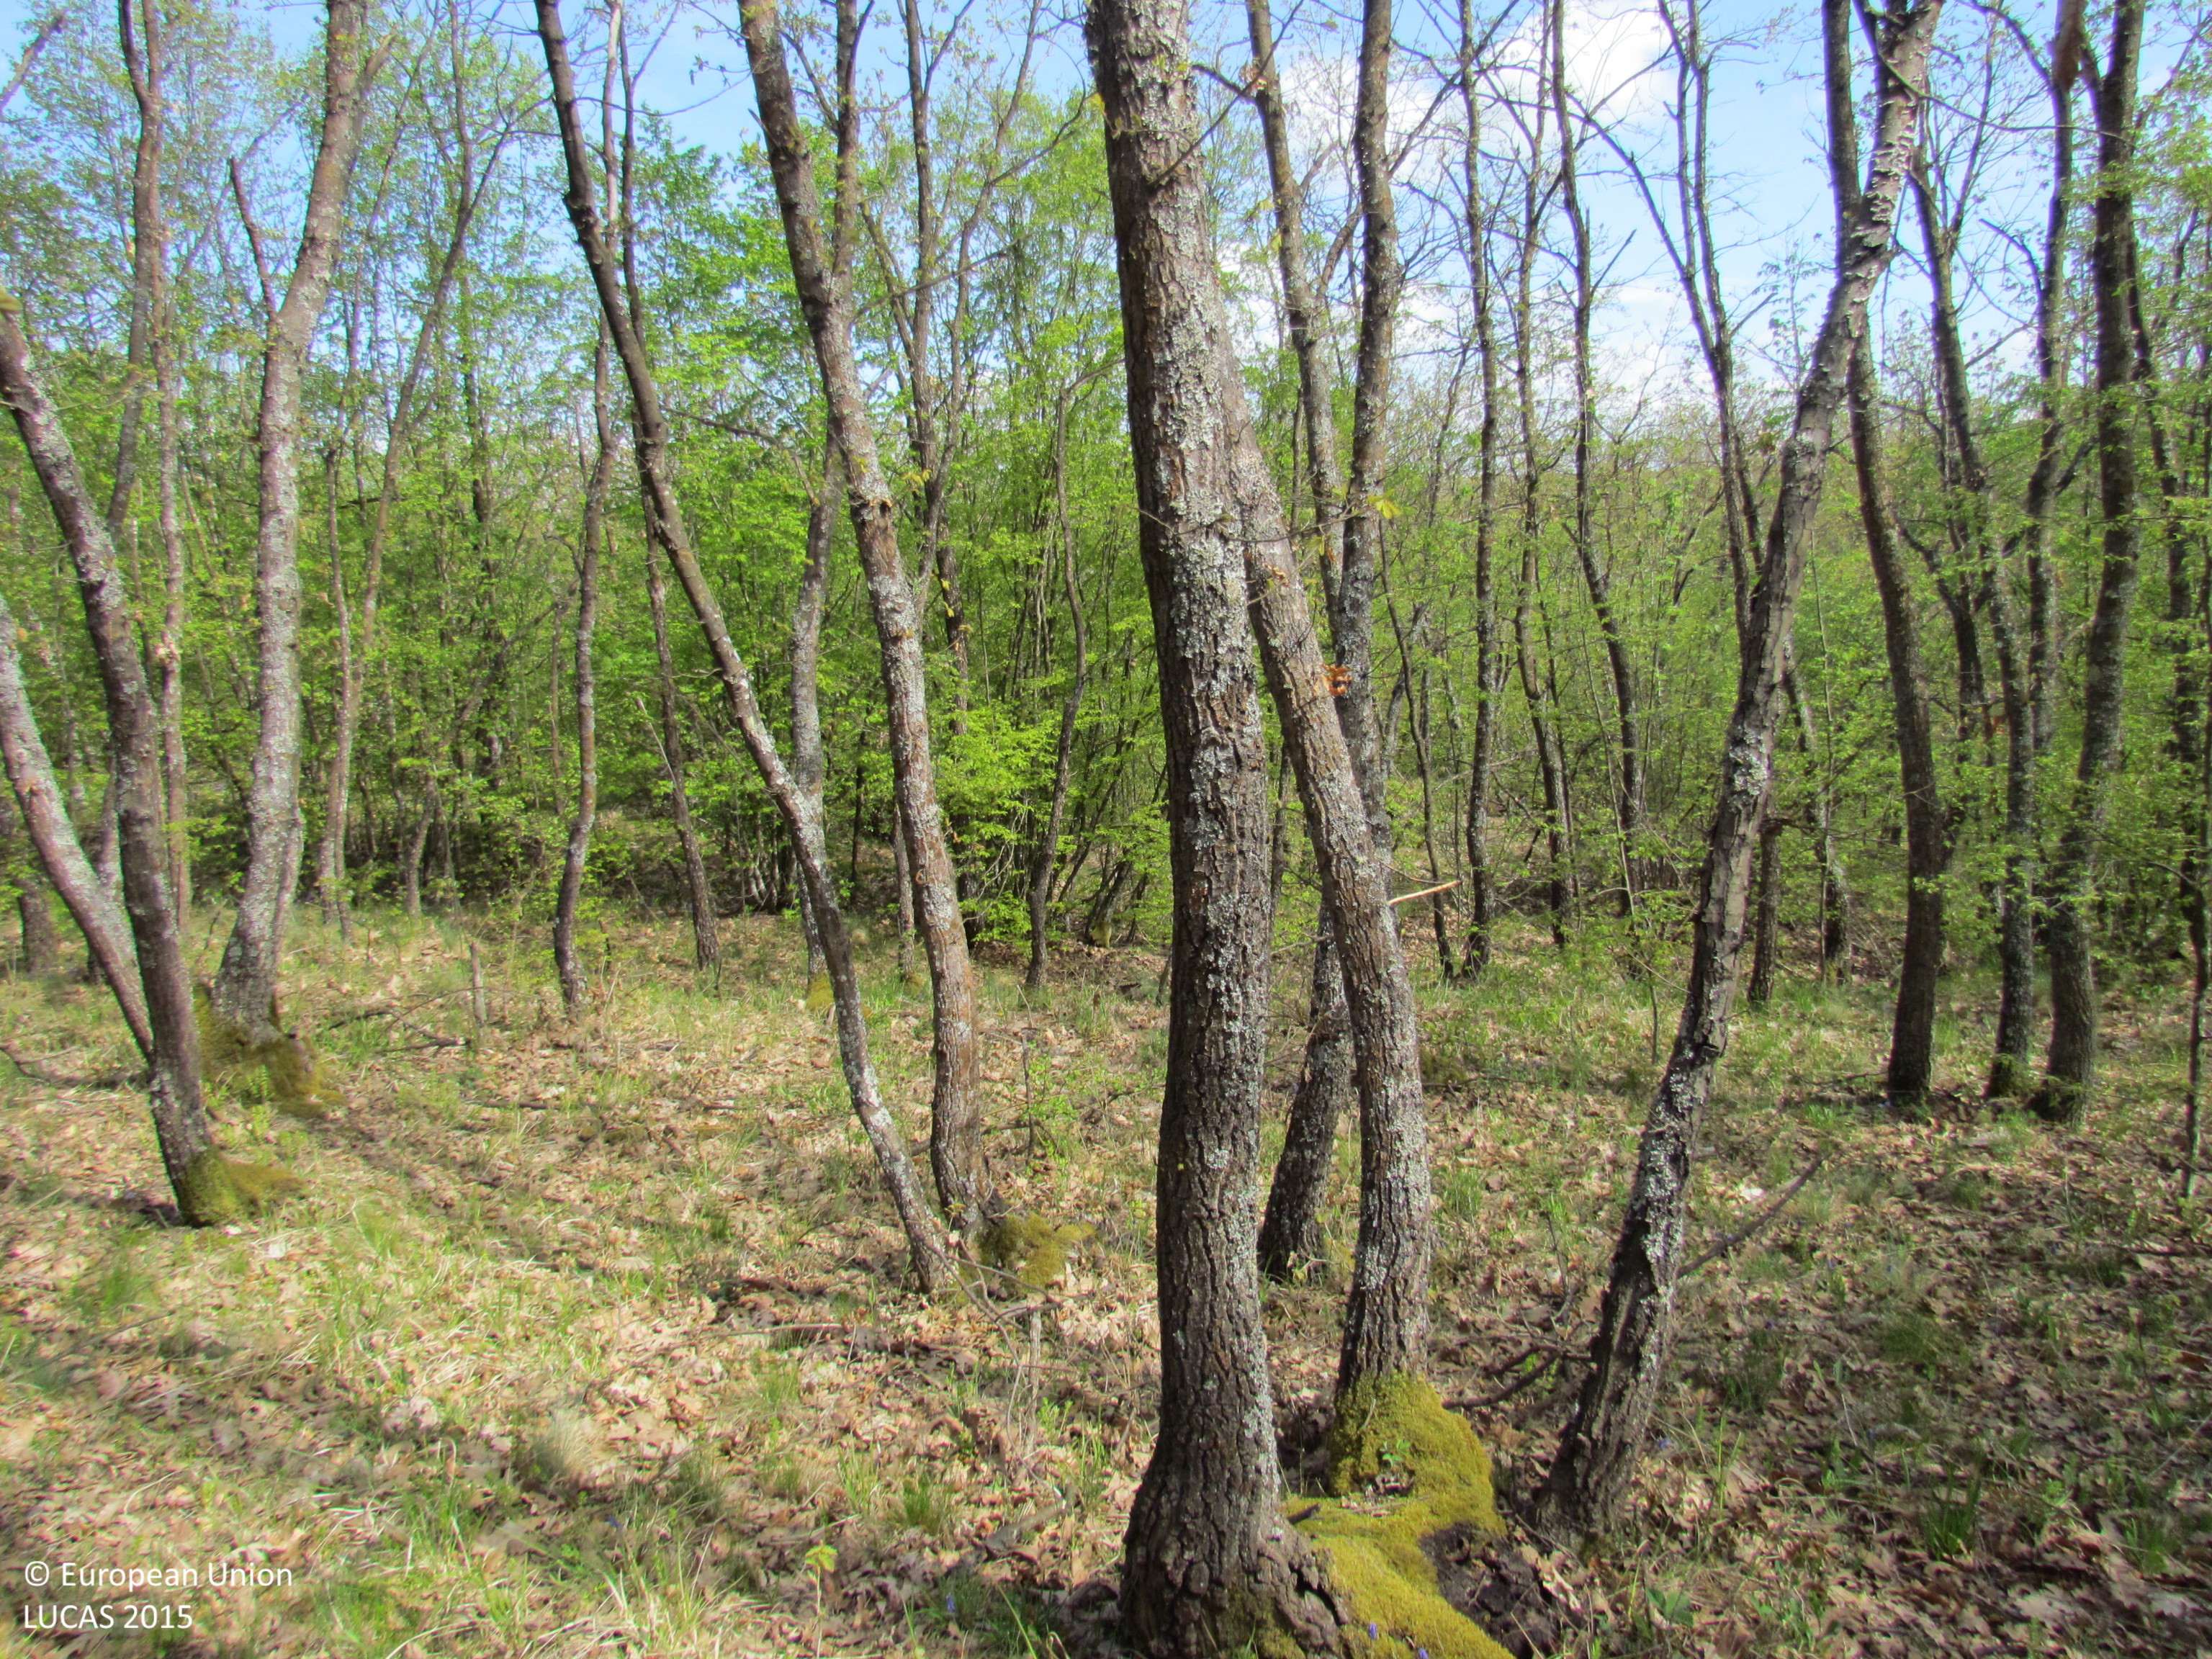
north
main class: Woodland
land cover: Broadleaved woodland
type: mesophytic deciduous forest
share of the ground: 50 - 75 %
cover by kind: broadleaved forest trees 70 %, consolidated bare surface 25 %, herbaceous plants 5 %
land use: Forestry
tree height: > 5 m
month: April
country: BG
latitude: 42.7834
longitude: 26.5881
